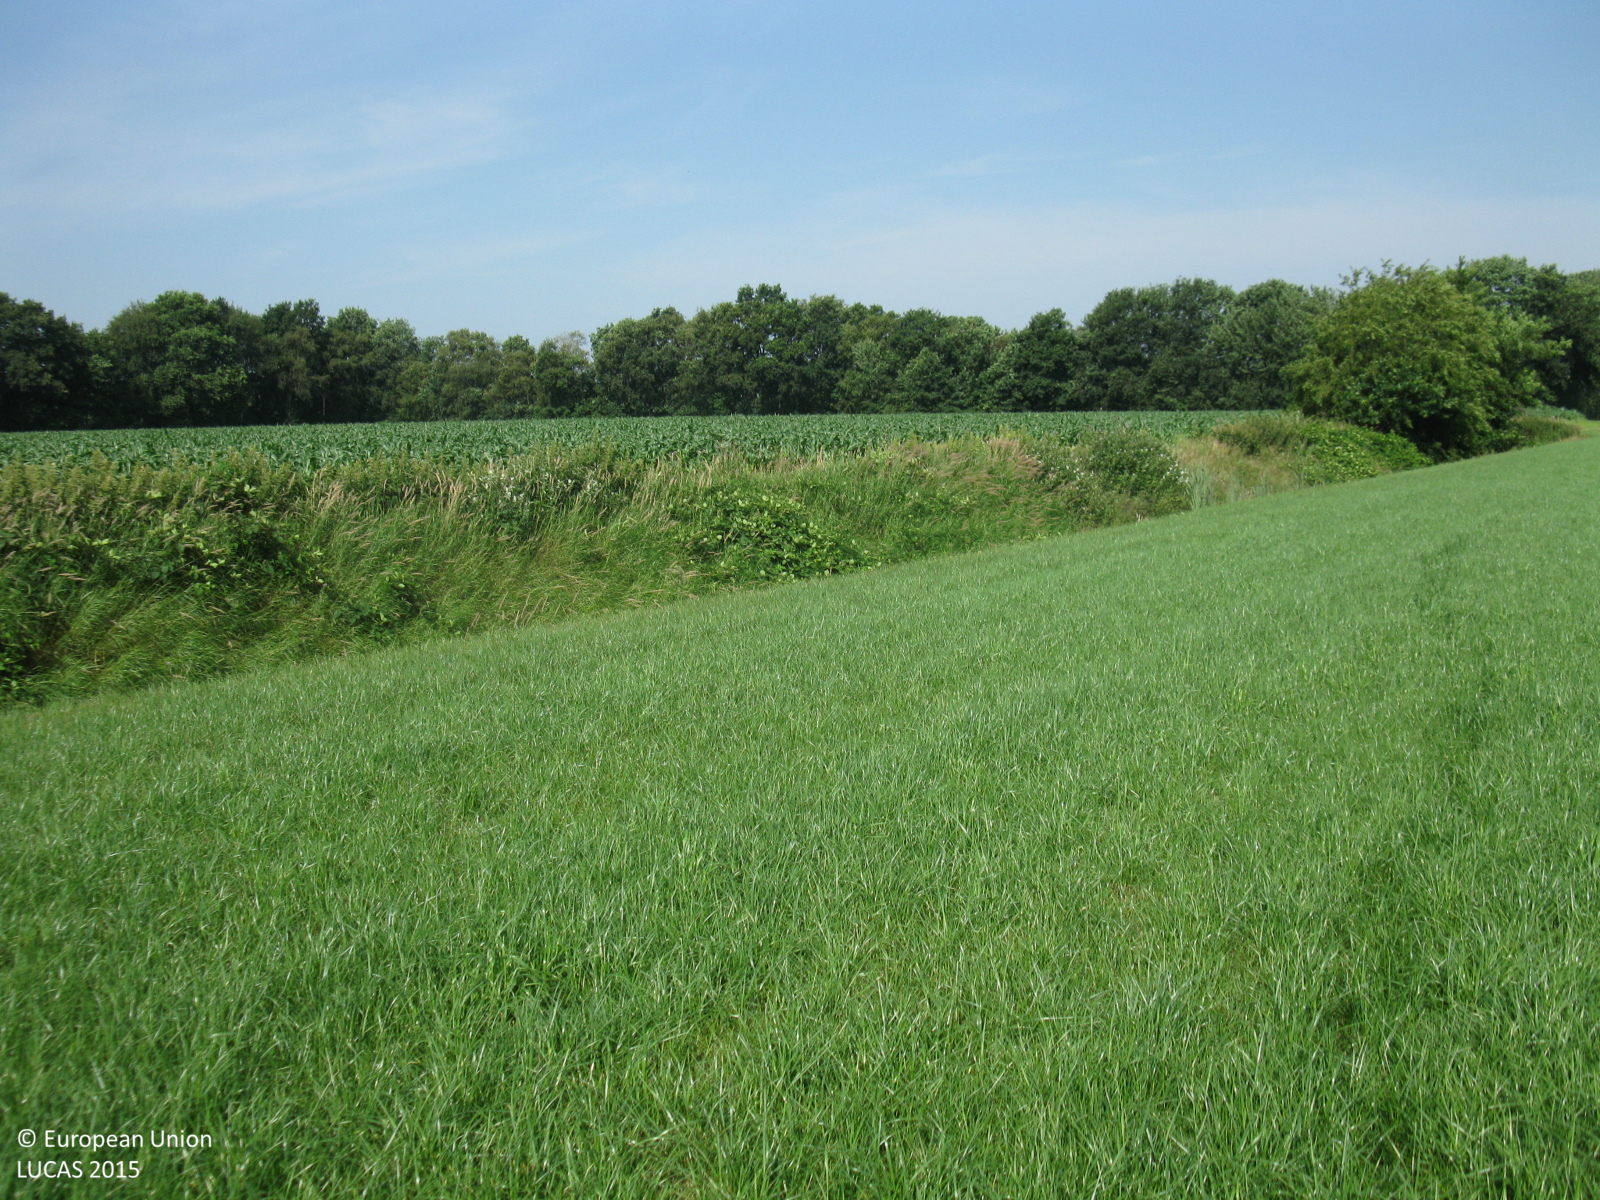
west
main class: Grassland
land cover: Grassland without tree/shrub cover
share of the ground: > 75 %
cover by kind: herbaceous plants 100 %
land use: Agriculture (excluding fallow land and kitchen gardens)
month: July
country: DE
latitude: 53.1858
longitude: 7.8906
